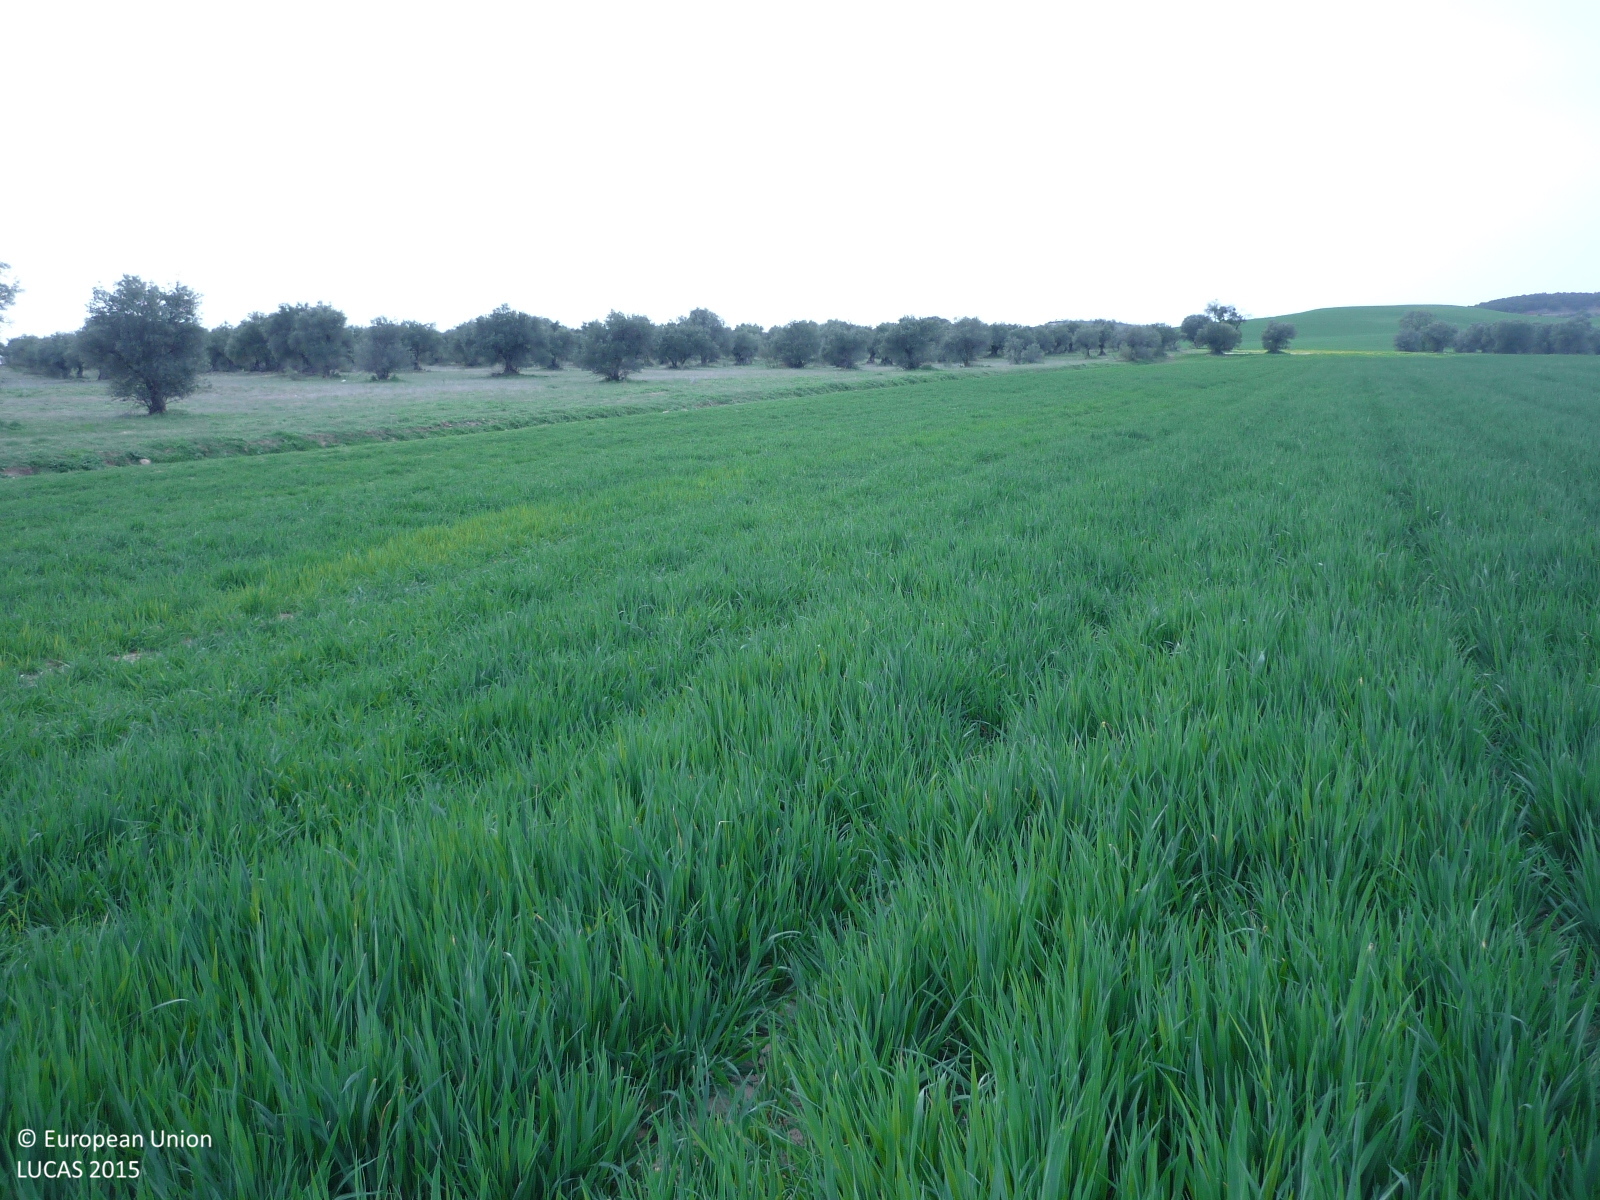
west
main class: Cropland
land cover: Rye
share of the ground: > 75 %
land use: Agriculture (excluding fallow land and kitchen gardens)
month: April
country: ES
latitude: 40.5854
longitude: -3.4221
